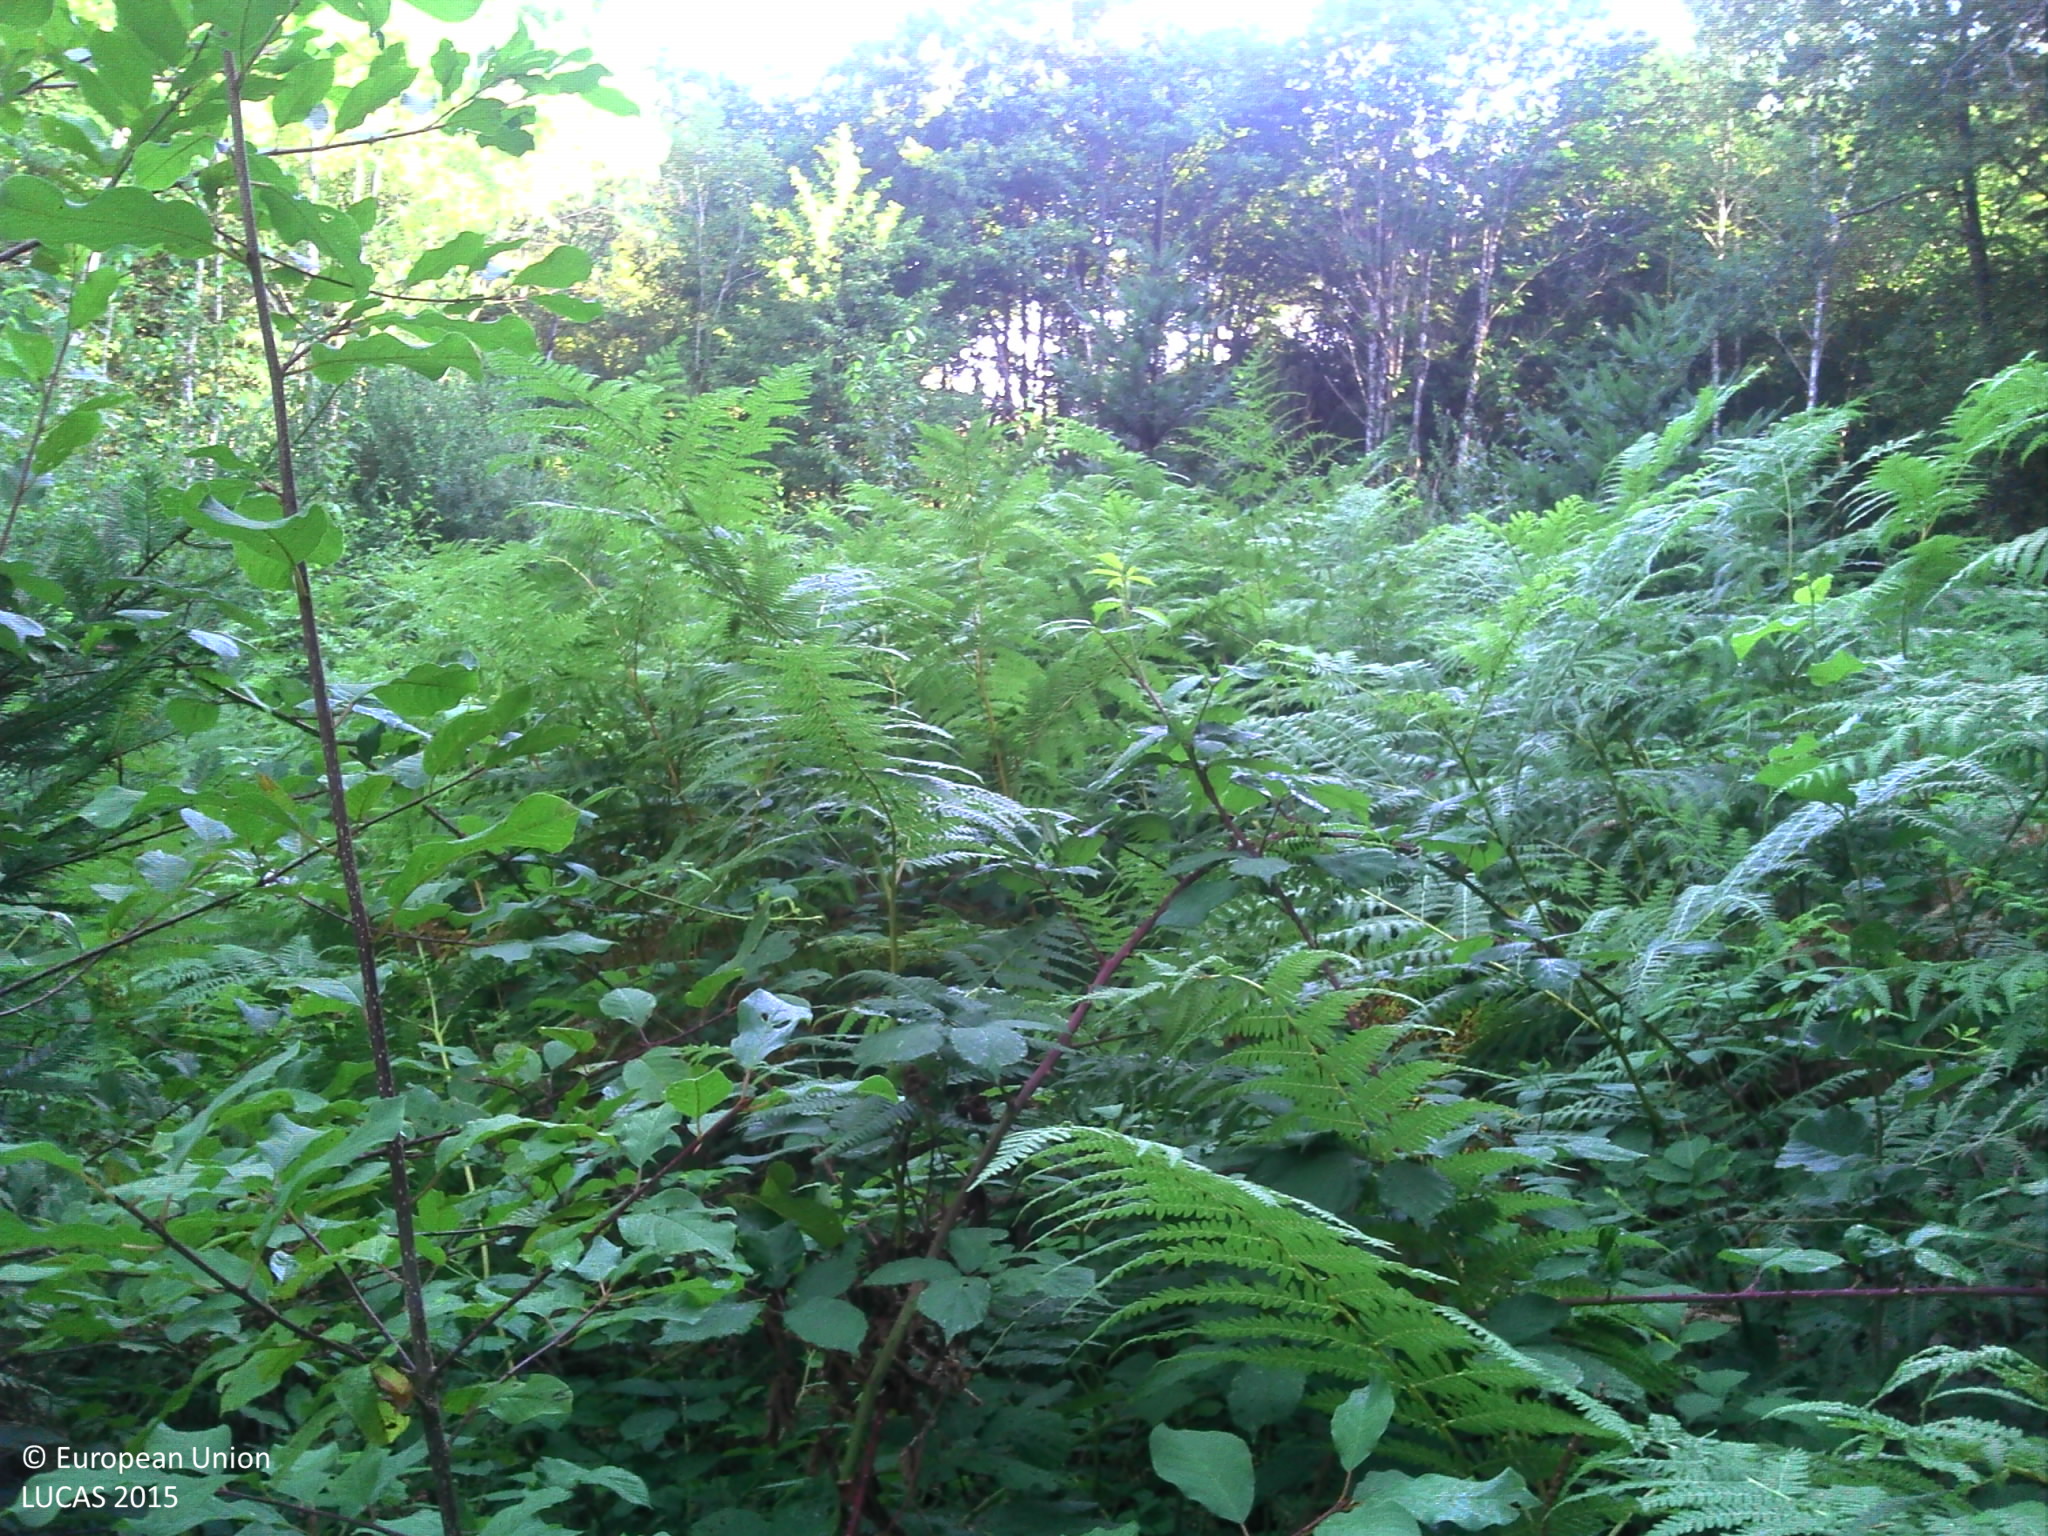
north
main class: Woodland
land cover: Spruce dominated coniferous woodland
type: exotic forest
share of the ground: > 75 %
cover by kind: coniferous forest trees 70 %, herbaceous plants 30 %
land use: Forestry
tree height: > 5 m
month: August
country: FR
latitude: 45.3730
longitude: 1.8879
